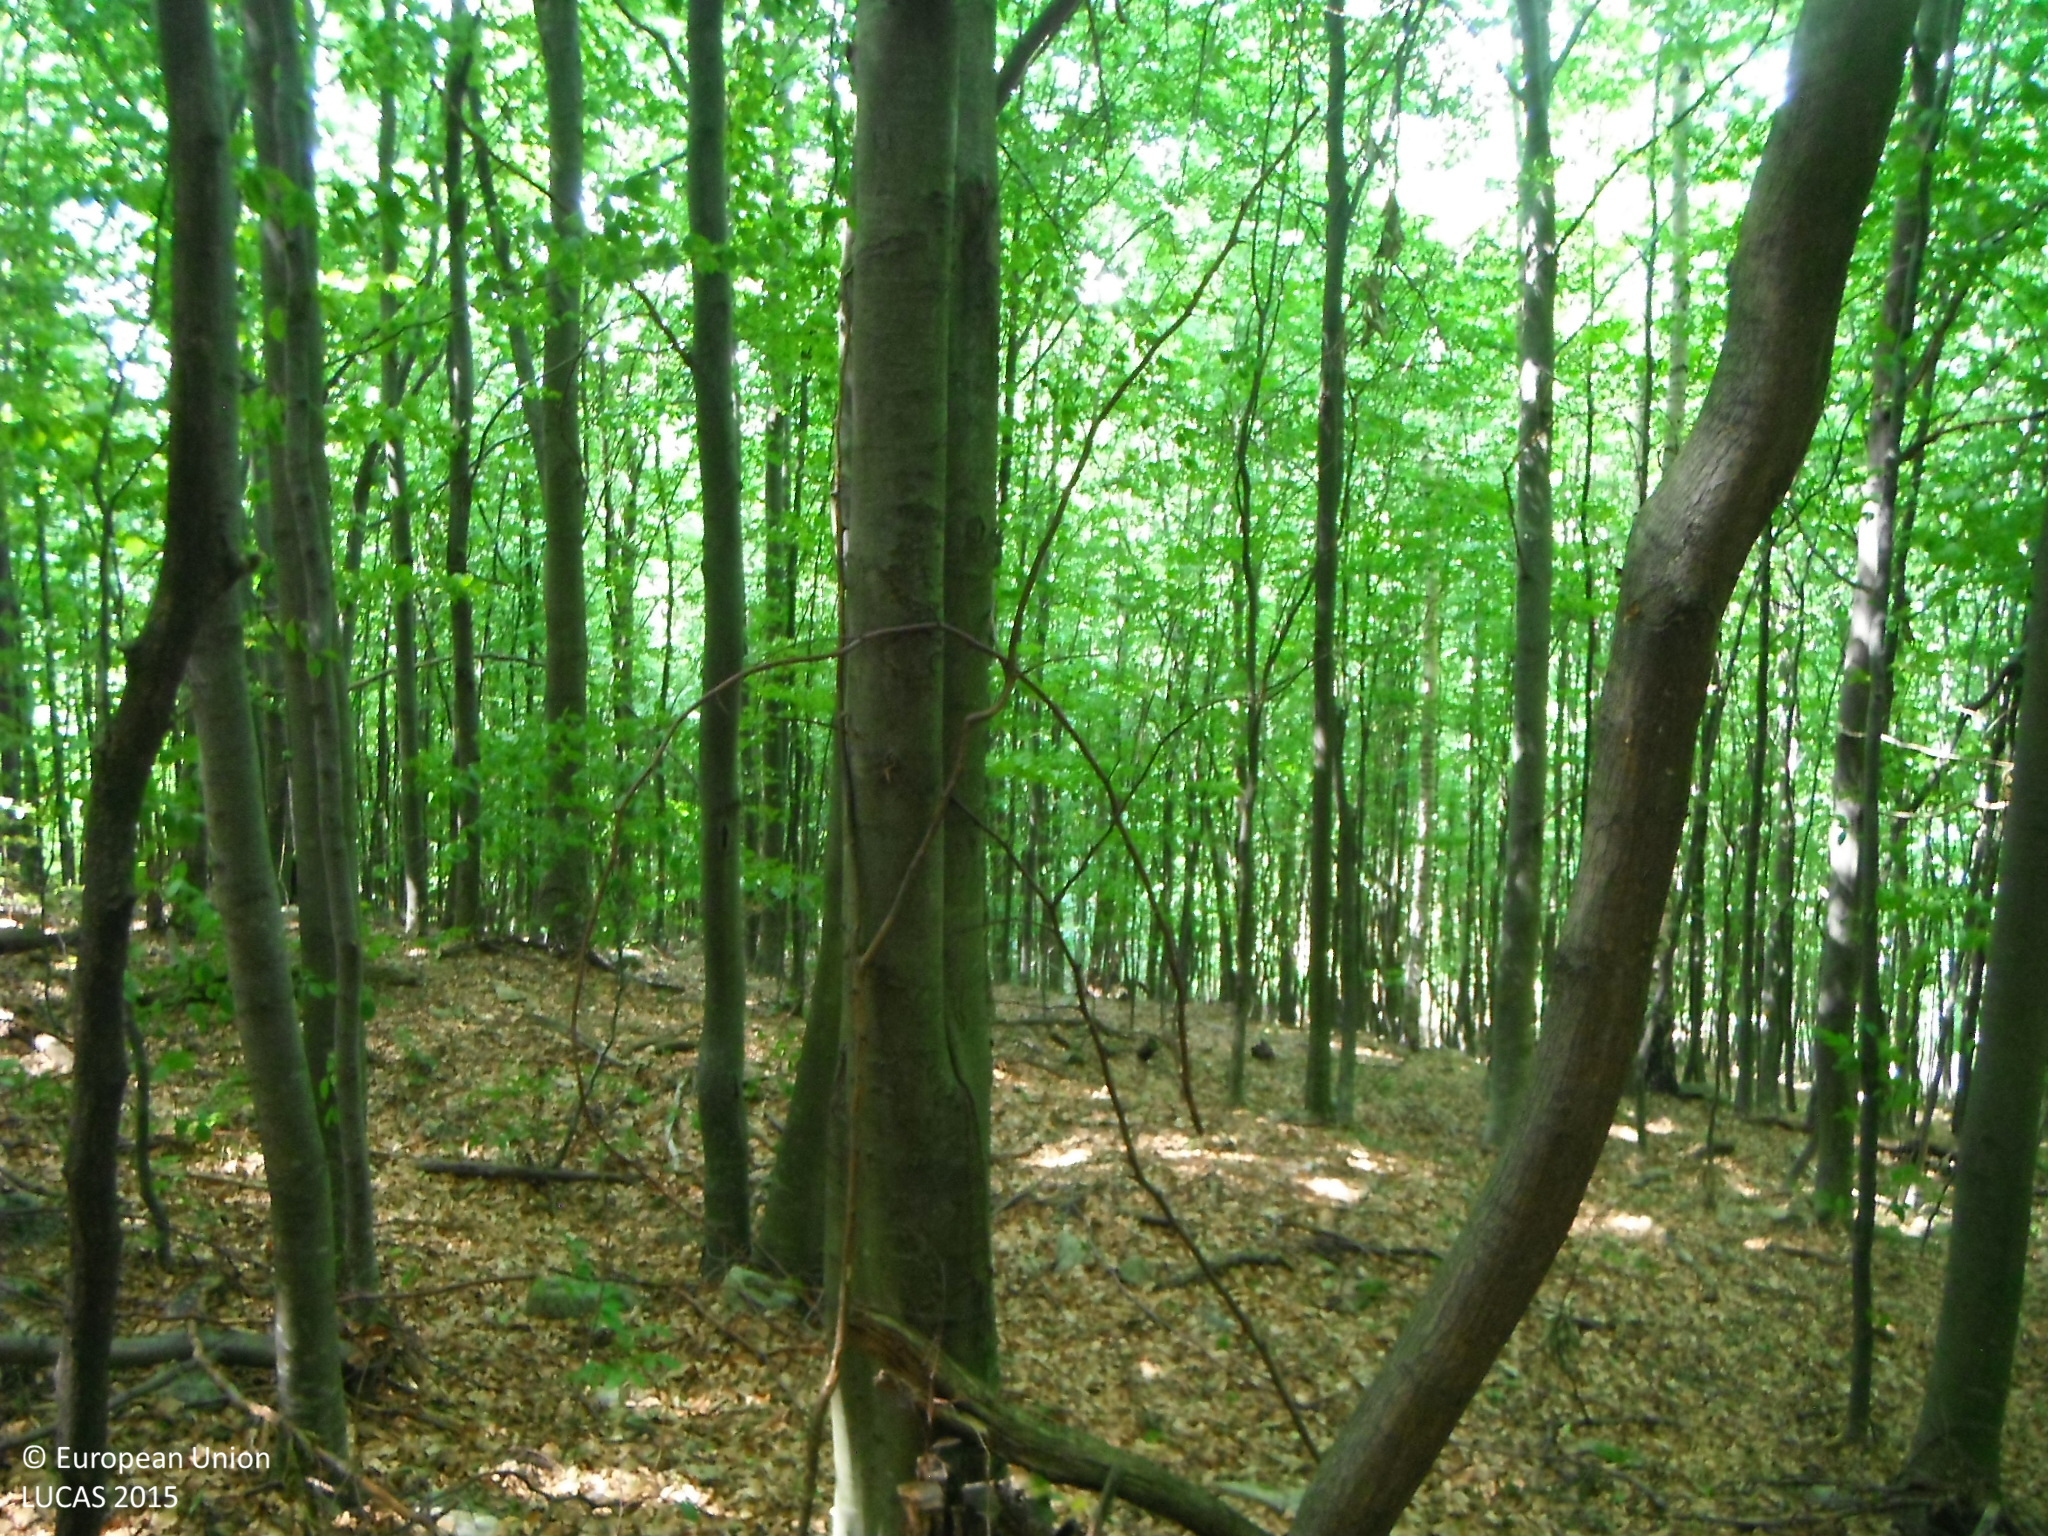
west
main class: Woodland
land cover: Broadleaved woodland
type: beech forest
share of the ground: > 75 %
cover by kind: broadleaved forest trees 100 %
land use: Forestry
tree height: > 5 m
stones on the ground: > 50 %
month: July
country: SK
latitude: 48.7394
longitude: 20.0798
